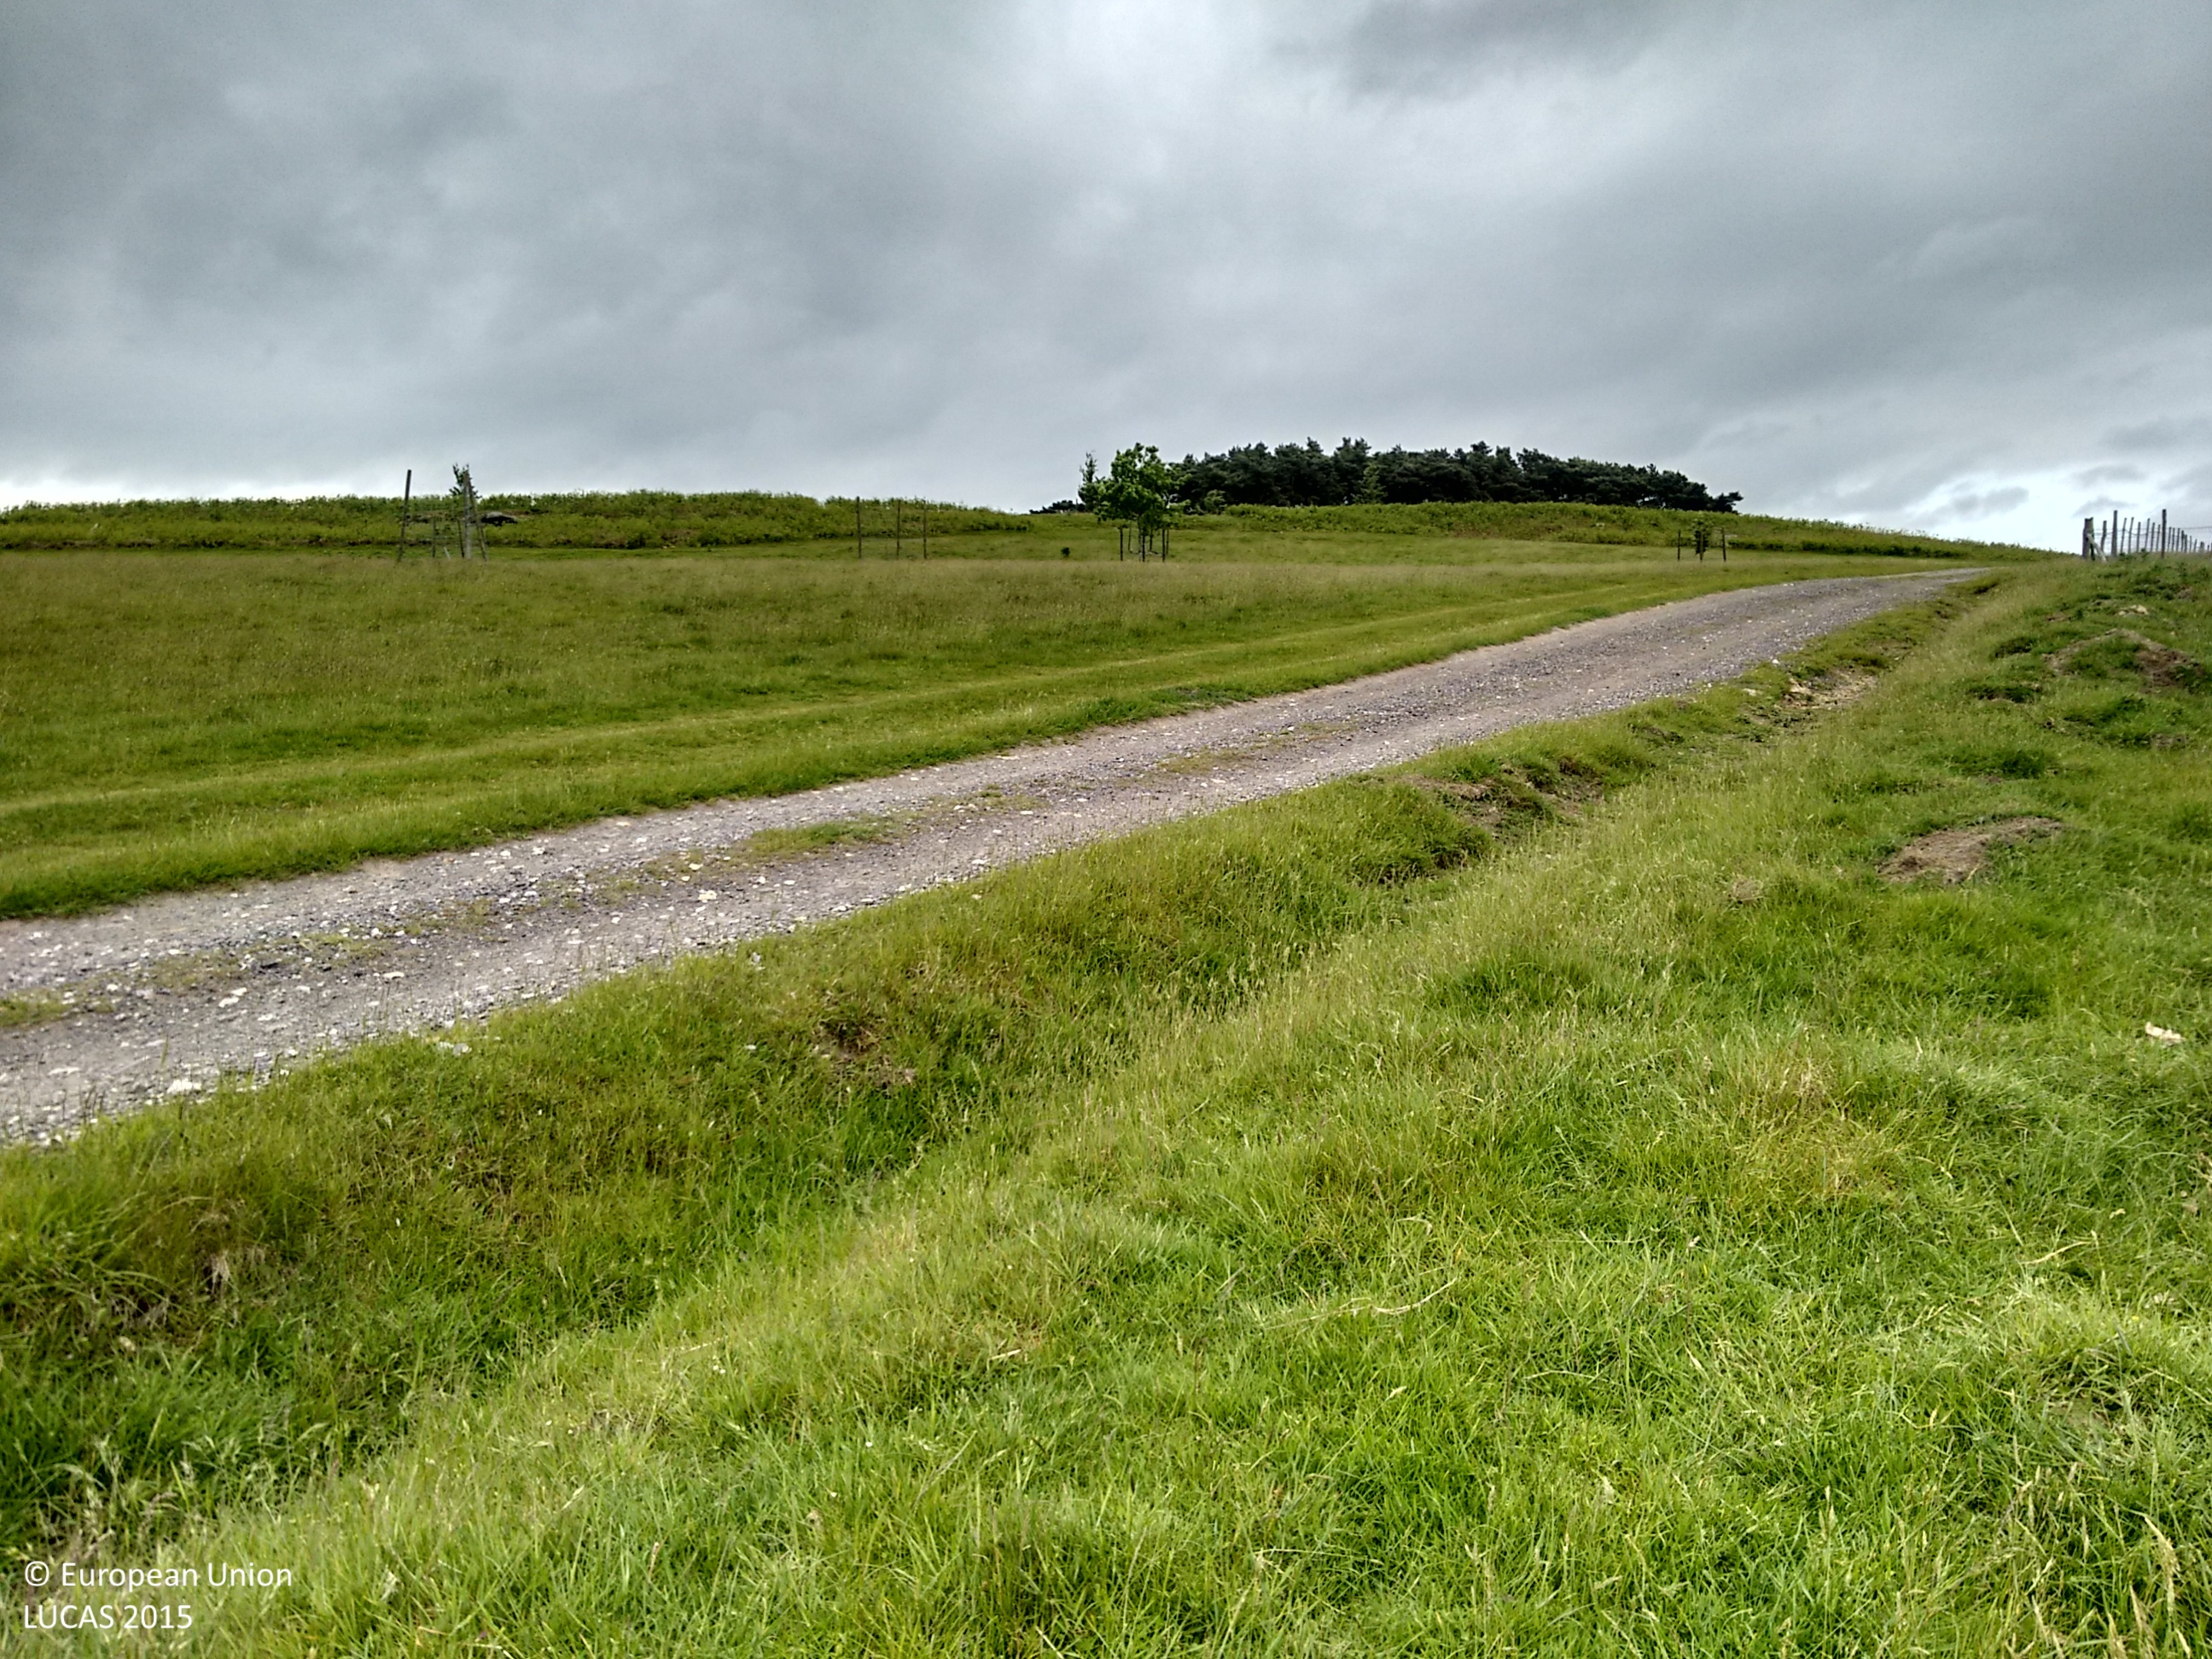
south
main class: Grassland
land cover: Grassland without tree/shrub cover
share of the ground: > 75 %
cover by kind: herbaceous plants 100 %
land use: Agriculture (excluding fallow land and kitchen gardens)
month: June
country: GB
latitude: 51.0875
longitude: 0.2473
